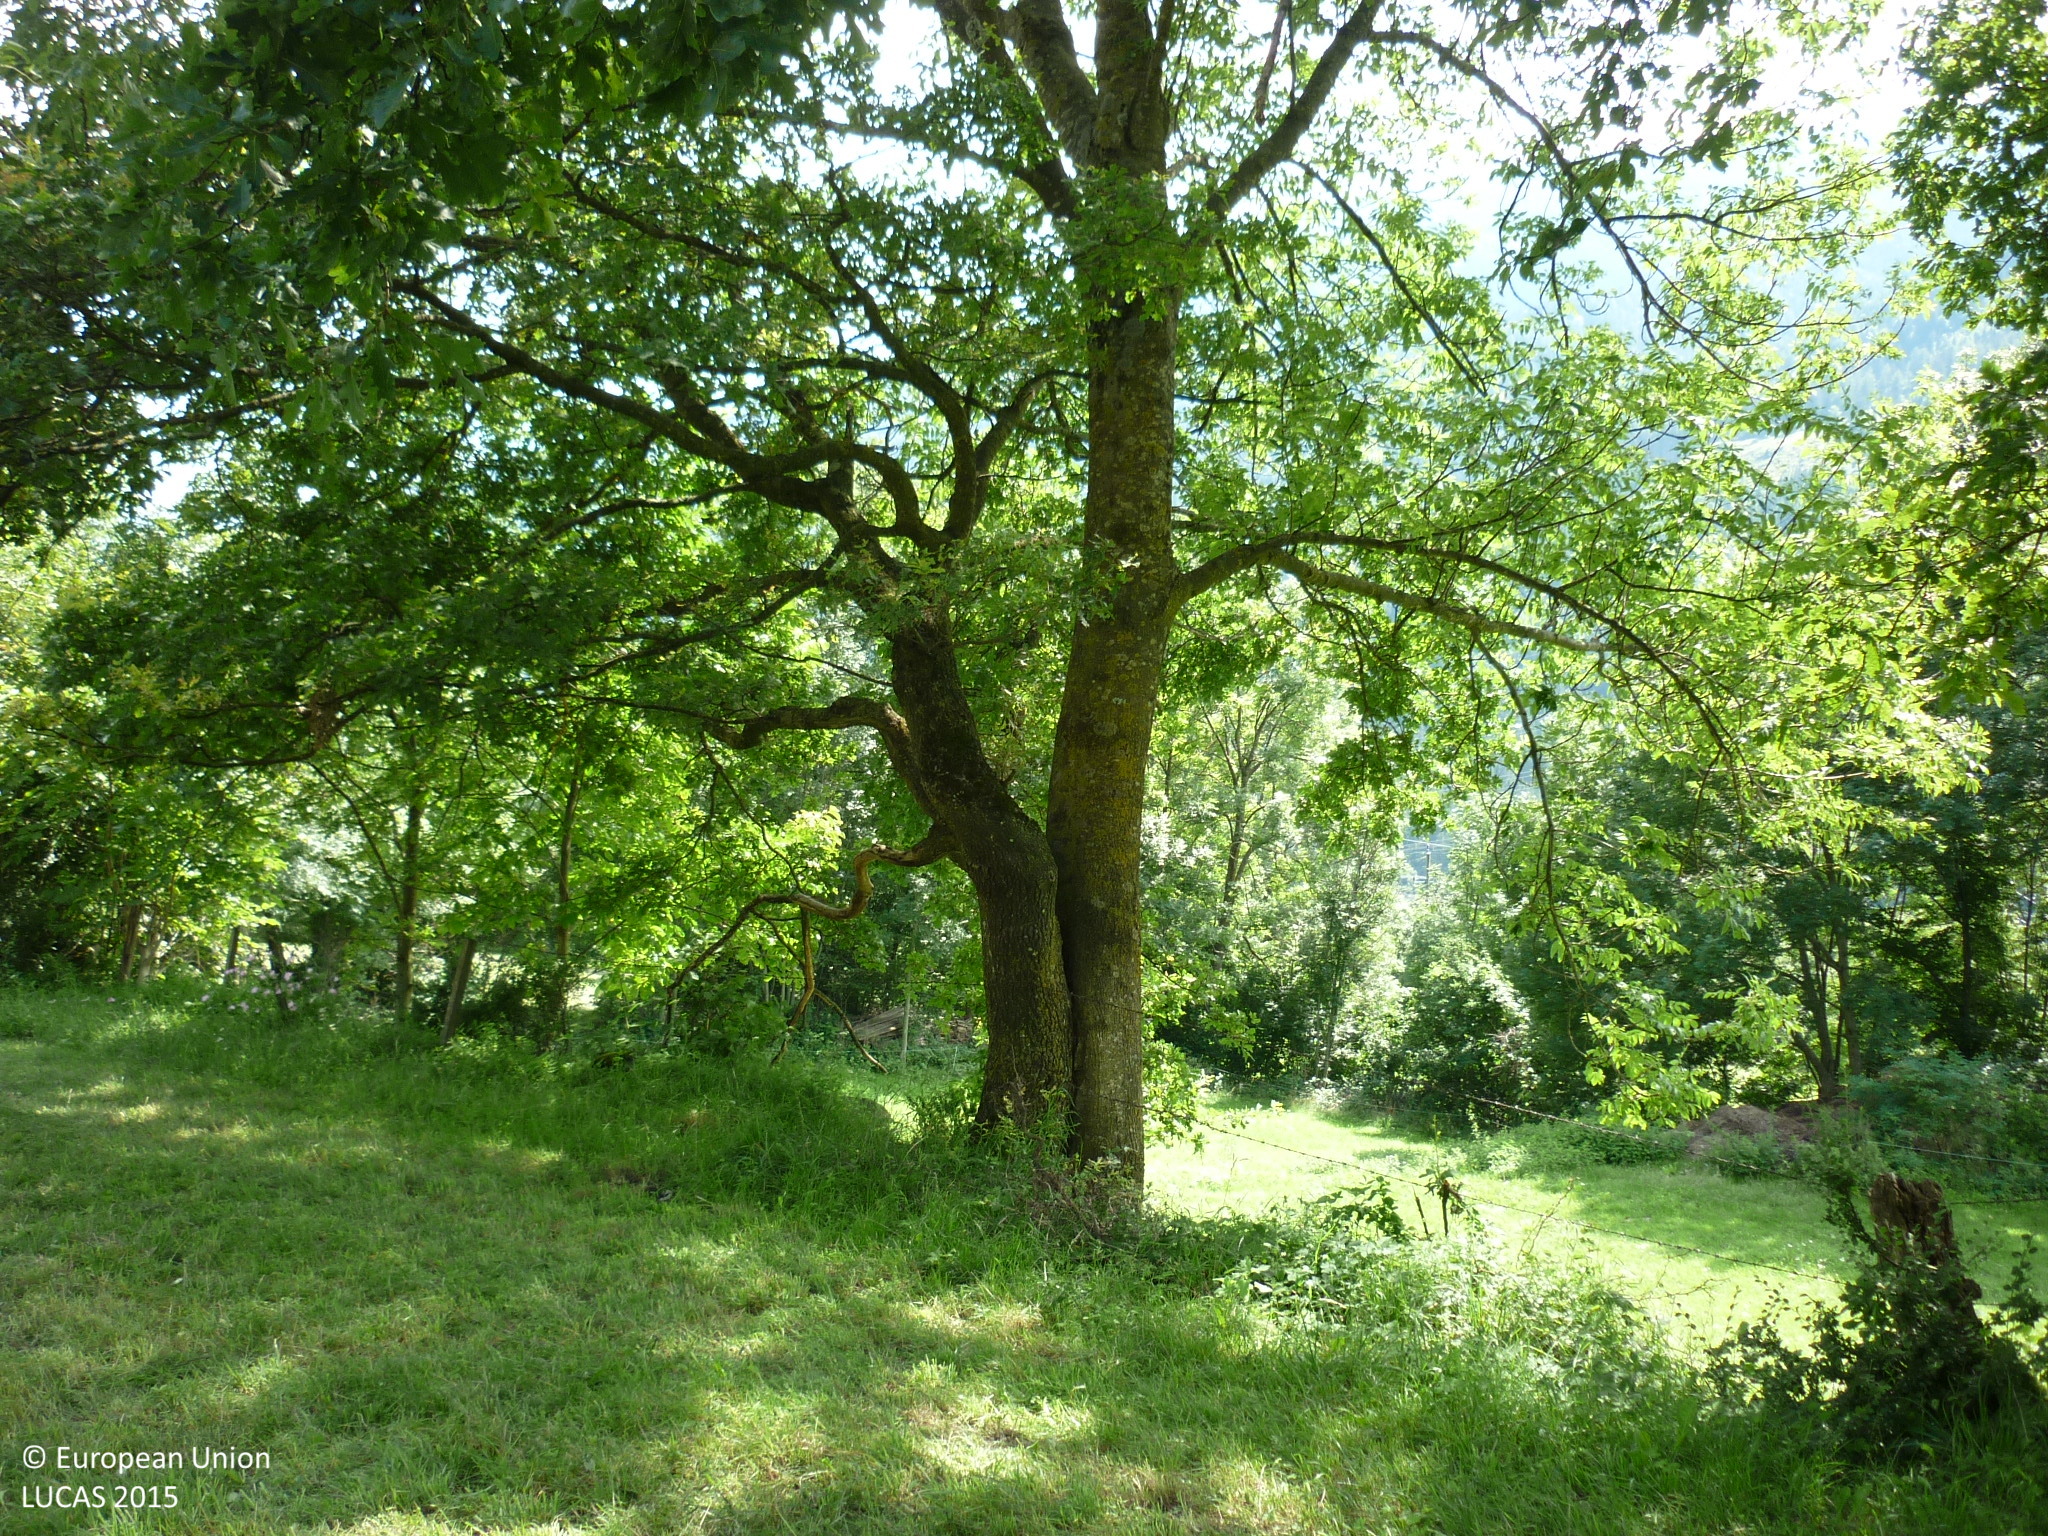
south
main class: Grassland
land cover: Grassland without tree/shrub cover
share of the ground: > 75 %
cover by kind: herbaceous plants 100 %
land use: Agriculture (excluding fallow land and kitchen gardens)
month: August
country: AT
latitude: 46.8766
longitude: 13.3171
